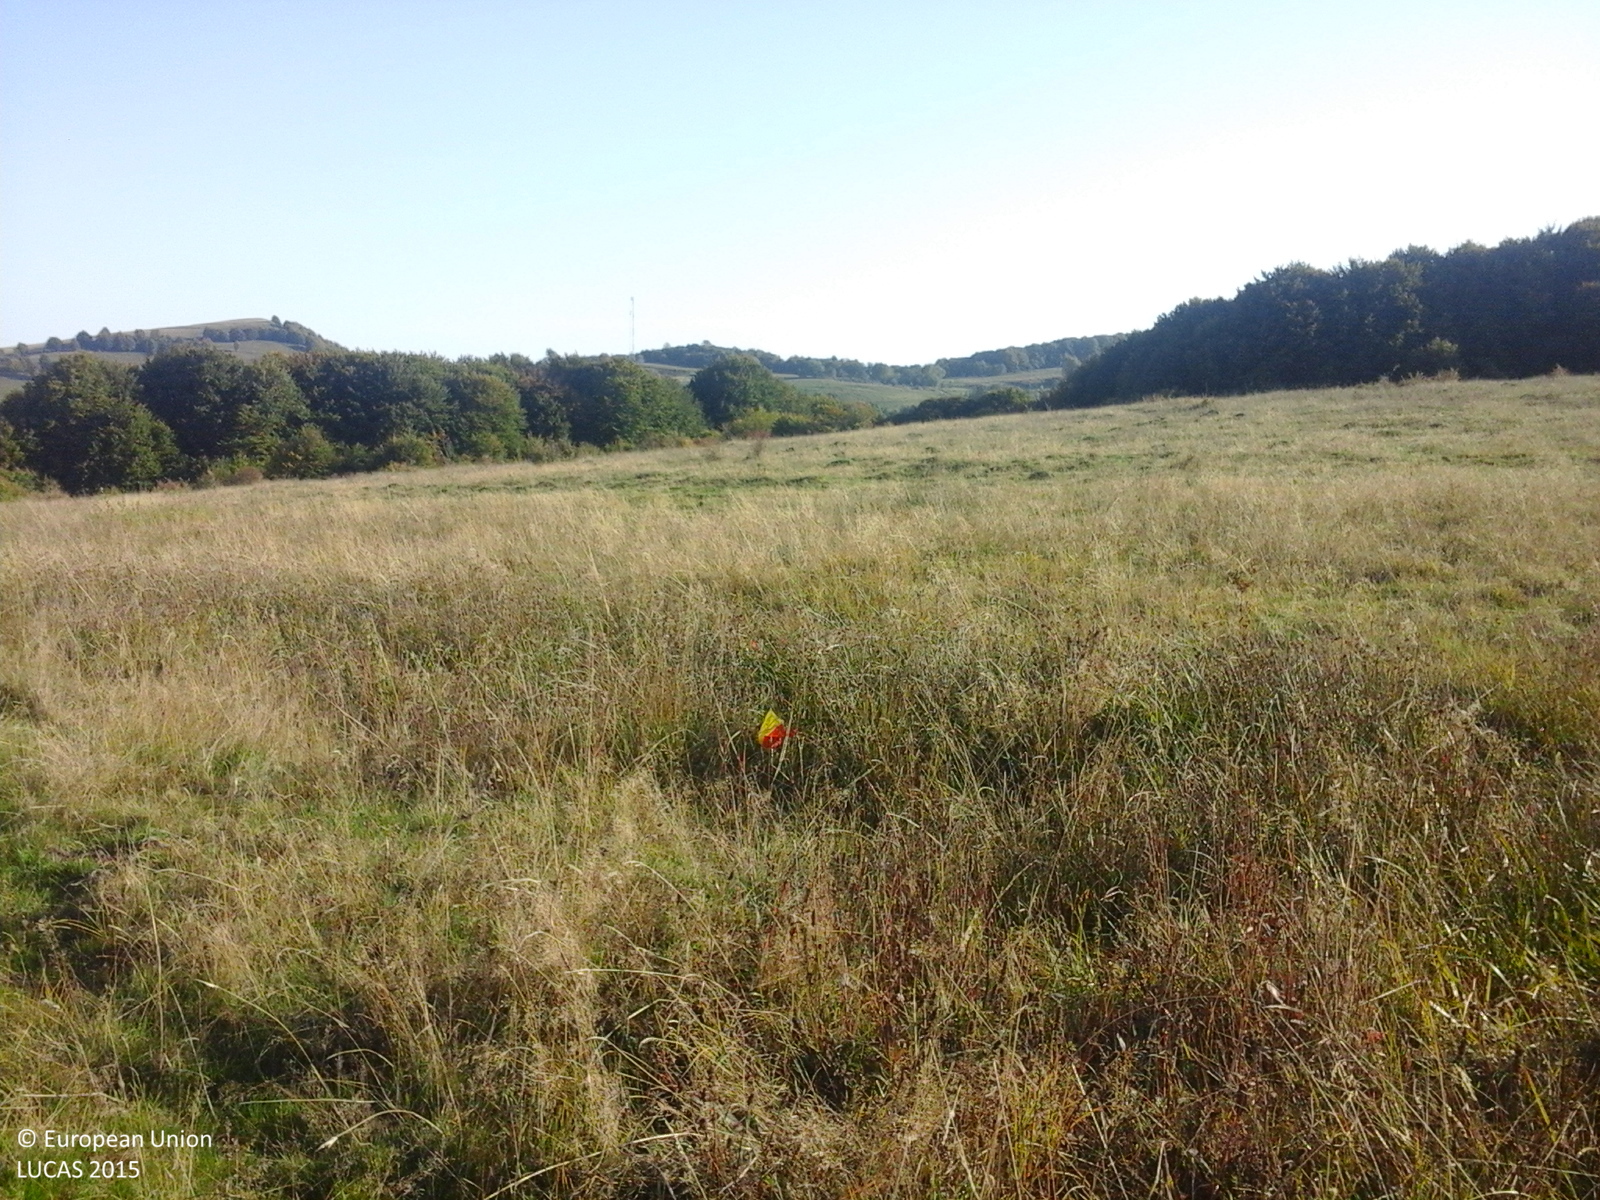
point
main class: Grassland
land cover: Grassland without tree/shrub cover
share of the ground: > 75 %
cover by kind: herbaceous plants 100 %
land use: Agriculture (excluding fallow land and kitchen gardens)
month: October
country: RO
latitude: 46.4526
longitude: 25.1637
